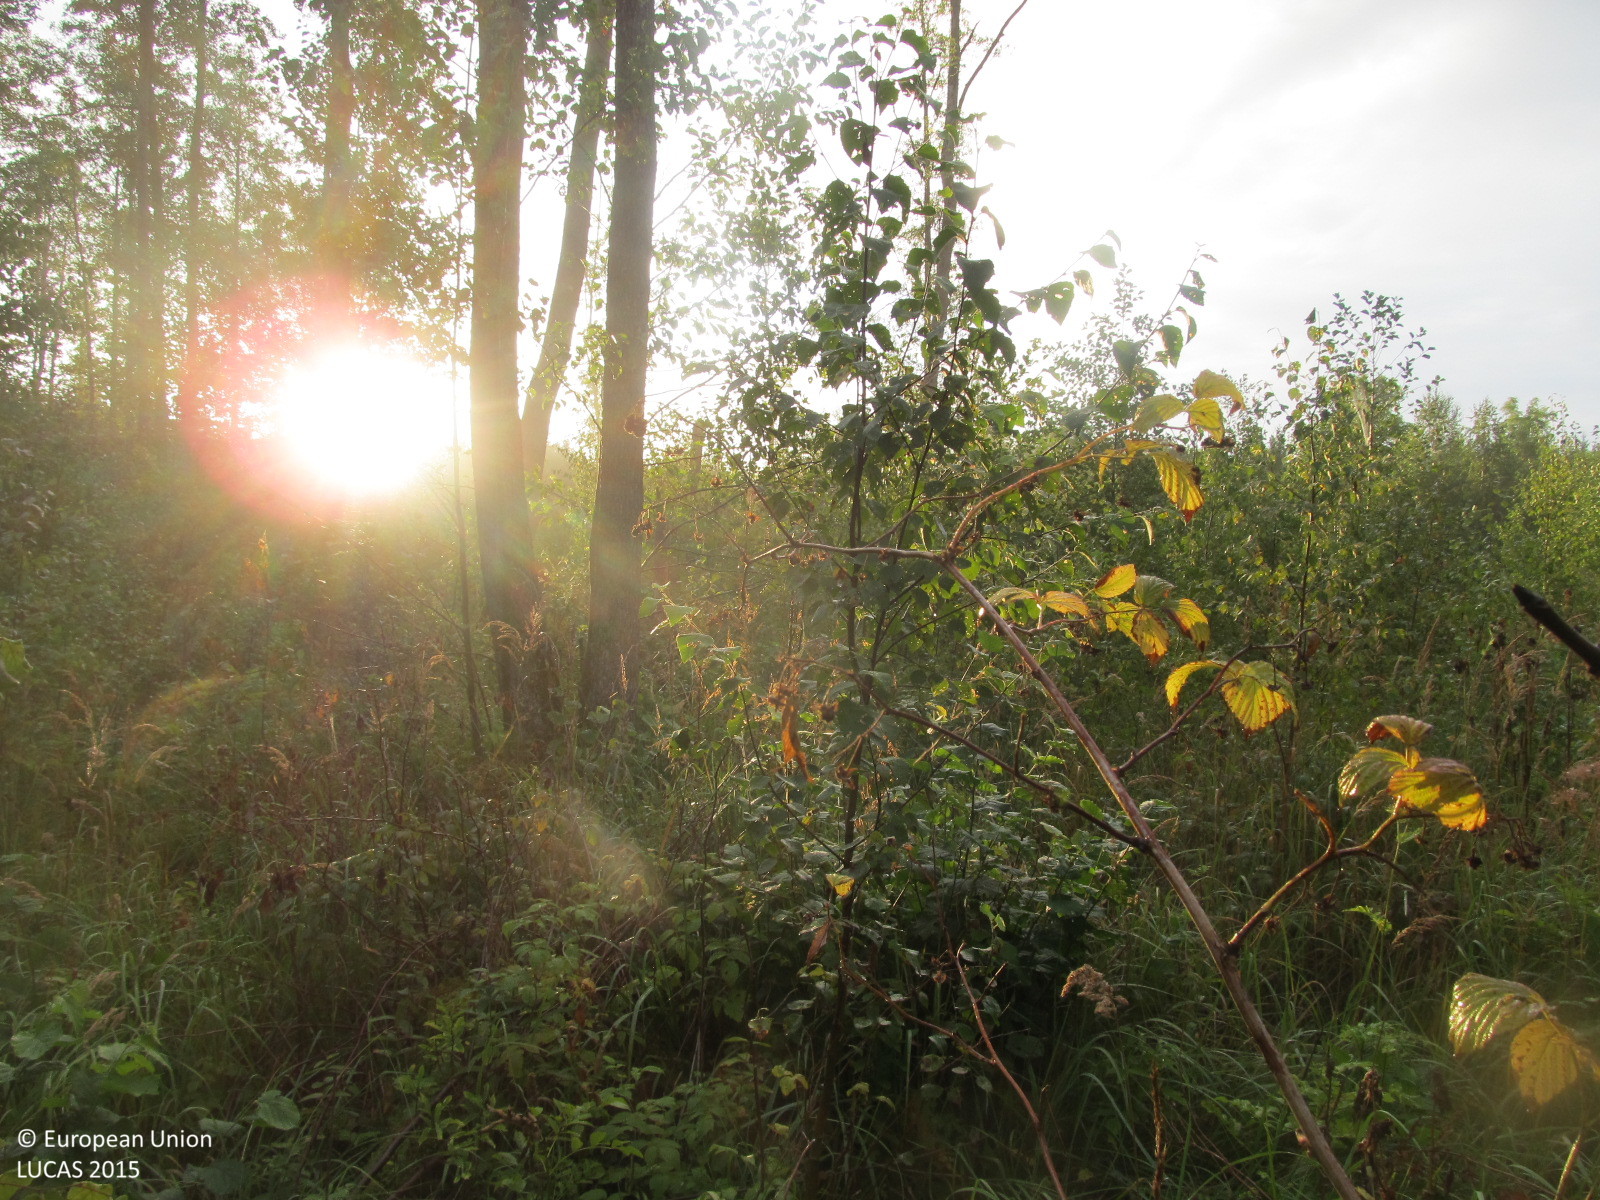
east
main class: Woodland
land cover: Broadleaved woodland
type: non-riverine alder, birch or aspen forest
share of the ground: > 75 %
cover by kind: broadleaved forest trees 75 %, shrubs 10 %, herbaceous plants 10 %, coniferous forest trees 5 %
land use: Forestry
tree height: < 5 m
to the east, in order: Broadleaved woodland; Other mixed woodland; Ditches and canals; Spruce dominated mixed woodland; Broadleaved woodland; Tracks; Broadleaved woodland
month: September
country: LT
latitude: 56.0516
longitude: 23.3526
